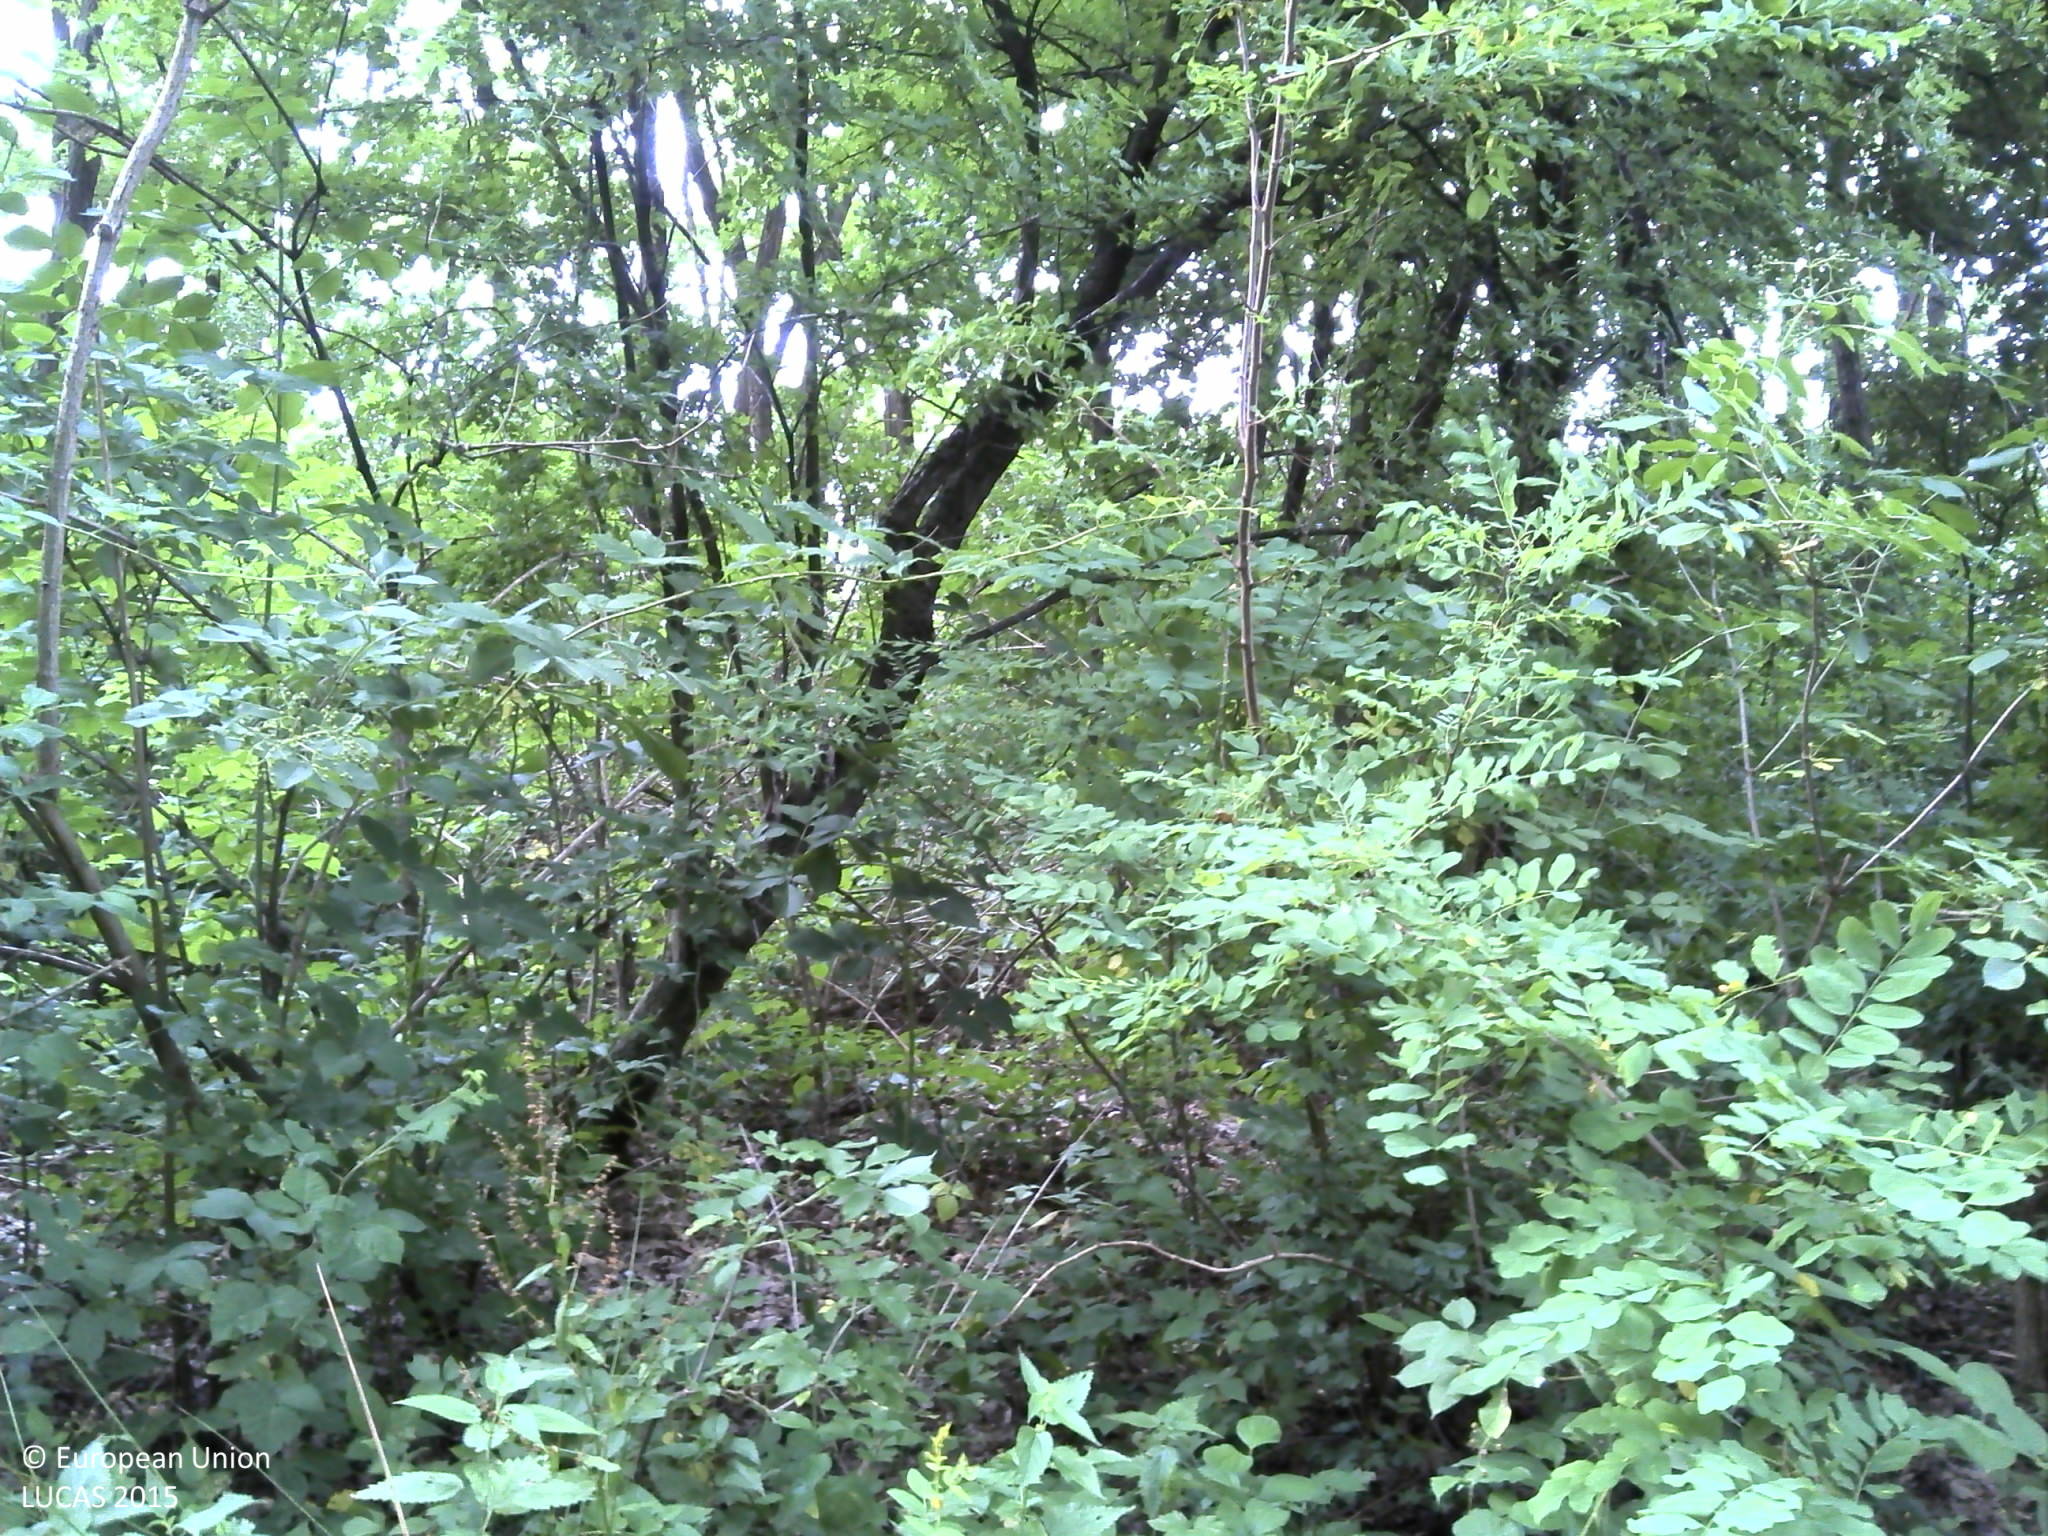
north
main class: Woodland
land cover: Broadleaved woodland
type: acidophilous oak and oak-birch forest
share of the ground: > 75 %
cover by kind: broadleaved forest trees 100 %
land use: Forestry
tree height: > 5 m
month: June
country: HR
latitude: 45.4186
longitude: 18.4528
